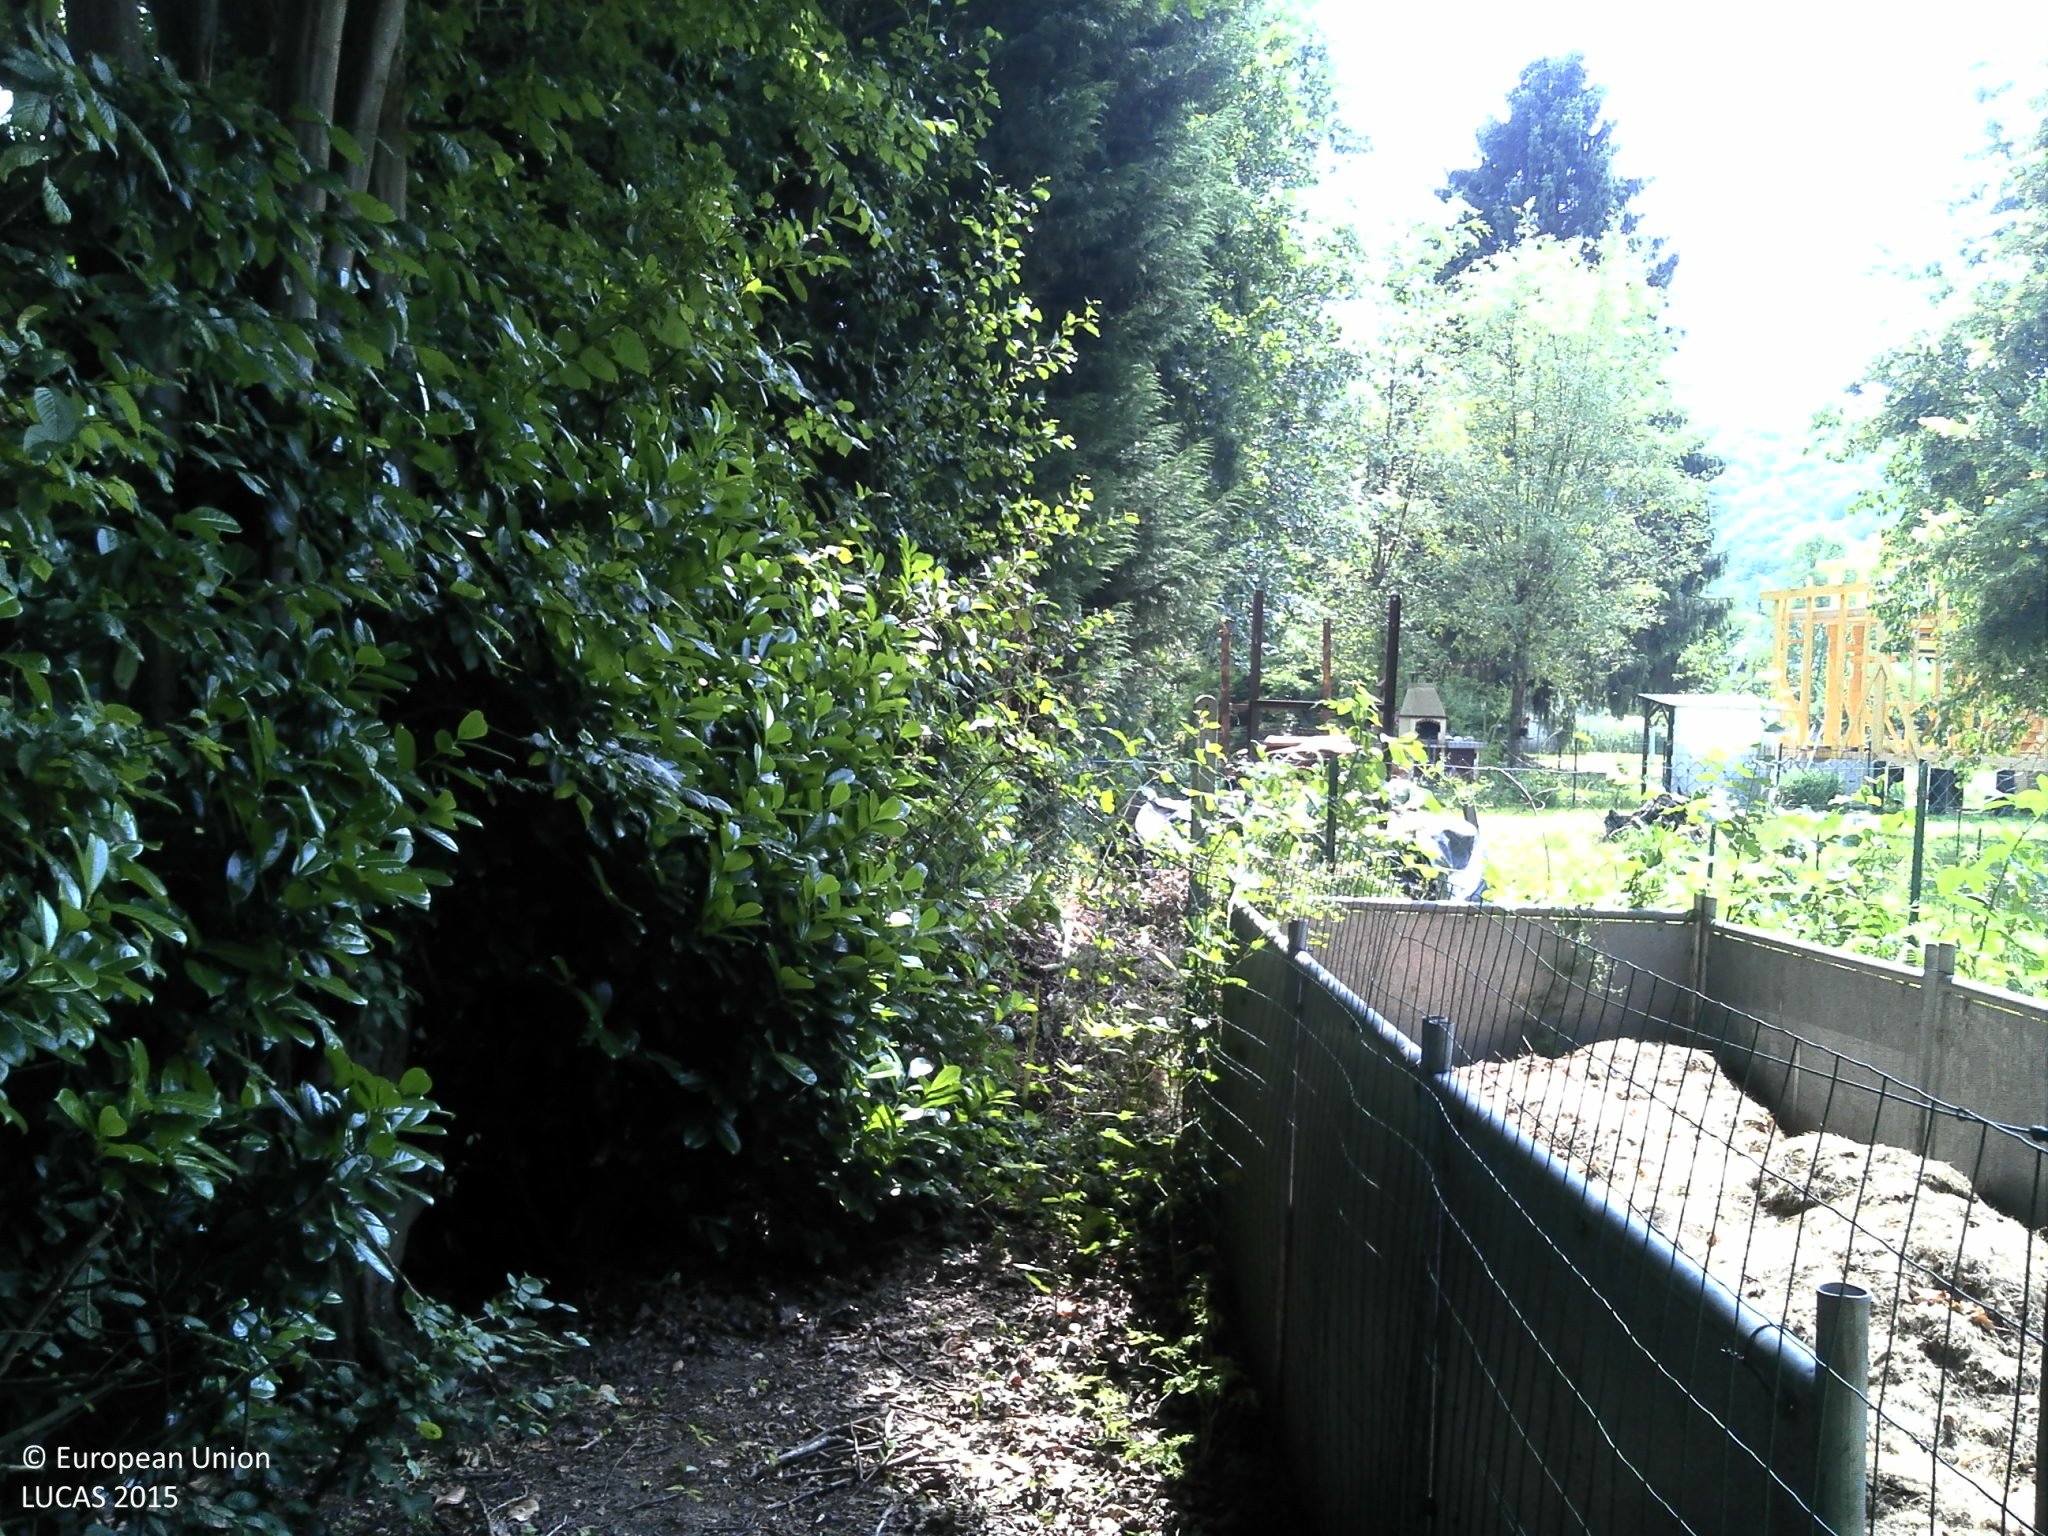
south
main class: Grassland
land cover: Grassland without tree/shrub cover
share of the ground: > 75 %
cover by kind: herbaceous plants 100 %
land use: Amenities, museums, leisure
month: July
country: FR
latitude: 49.8678
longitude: 4.8074
